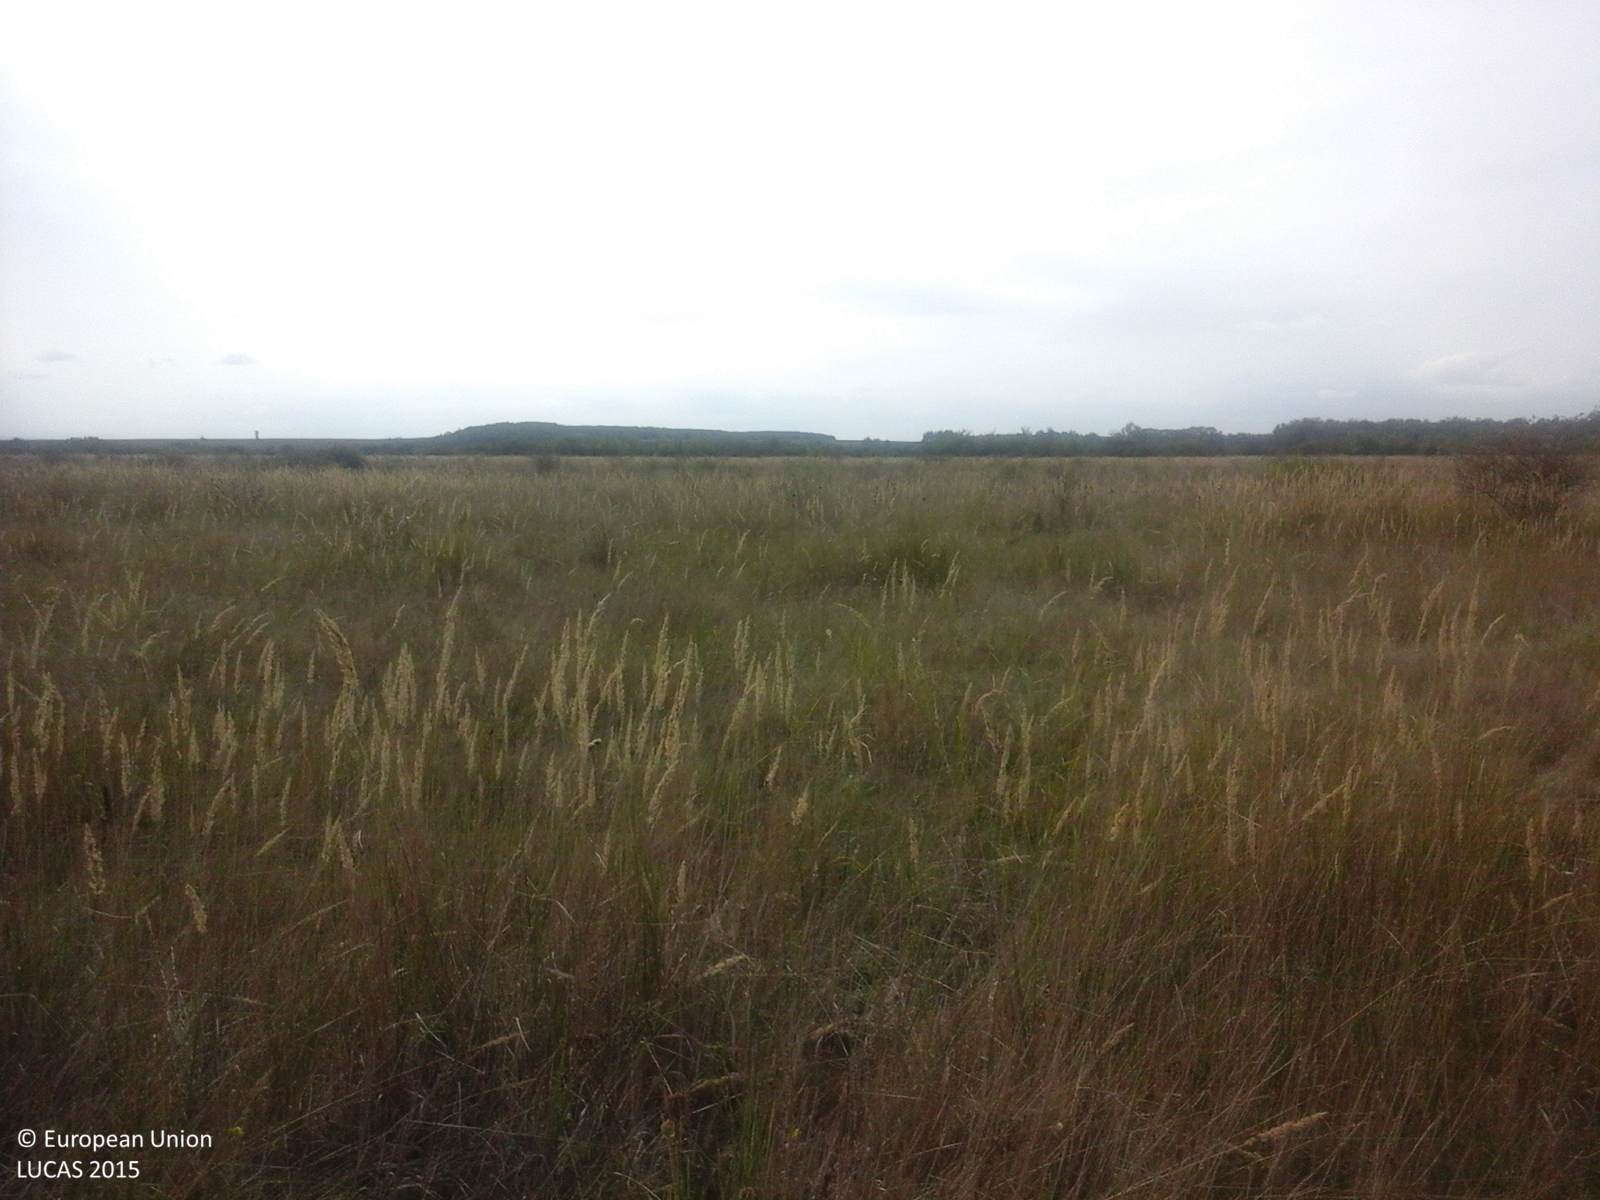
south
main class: Grassland
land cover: Spontaneously vegetated surfaces
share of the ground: > 75 %
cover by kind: herbaceous plants 100 %
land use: Fallow land
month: September
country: RO
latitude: 45.6413
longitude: 21.9577
